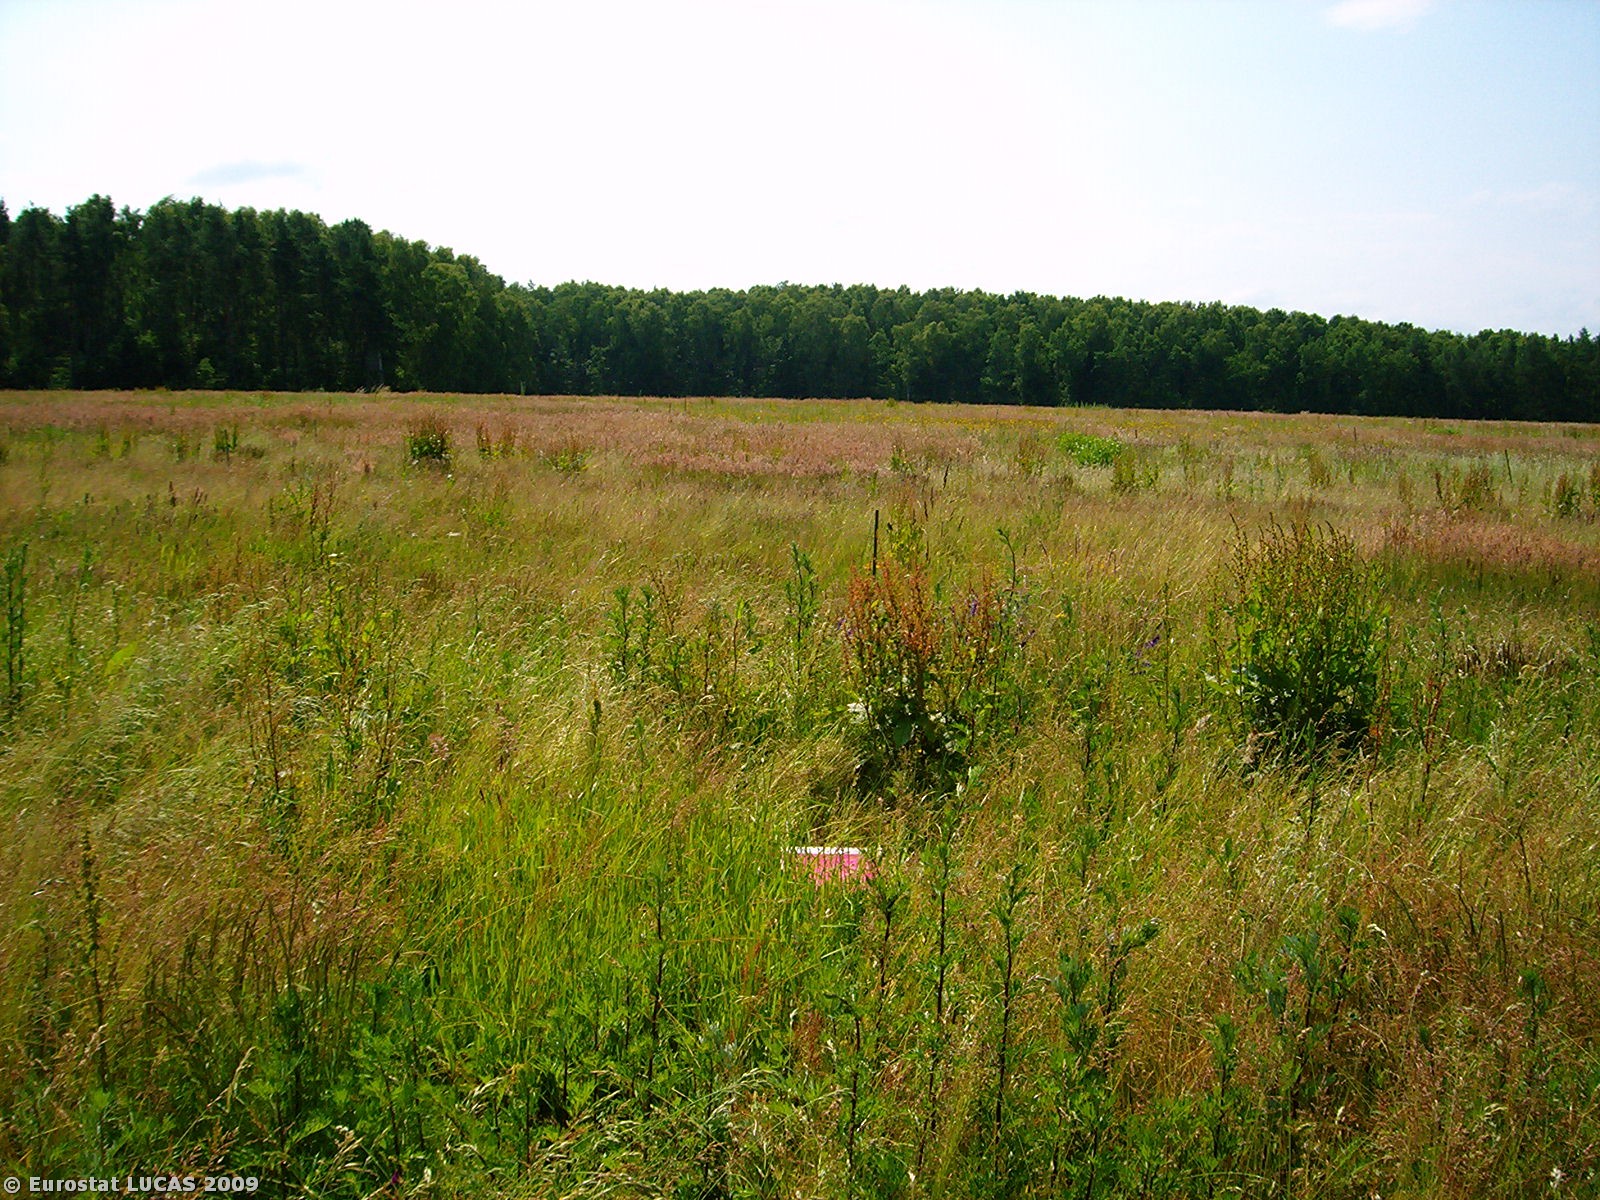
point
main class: Grassland
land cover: Grassland without tree/shrub cover
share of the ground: < 10 %
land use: Agriculture (excluding fallow land and kitchen gardens)
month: June
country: PL
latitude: 53.7079
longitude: 15.5329
